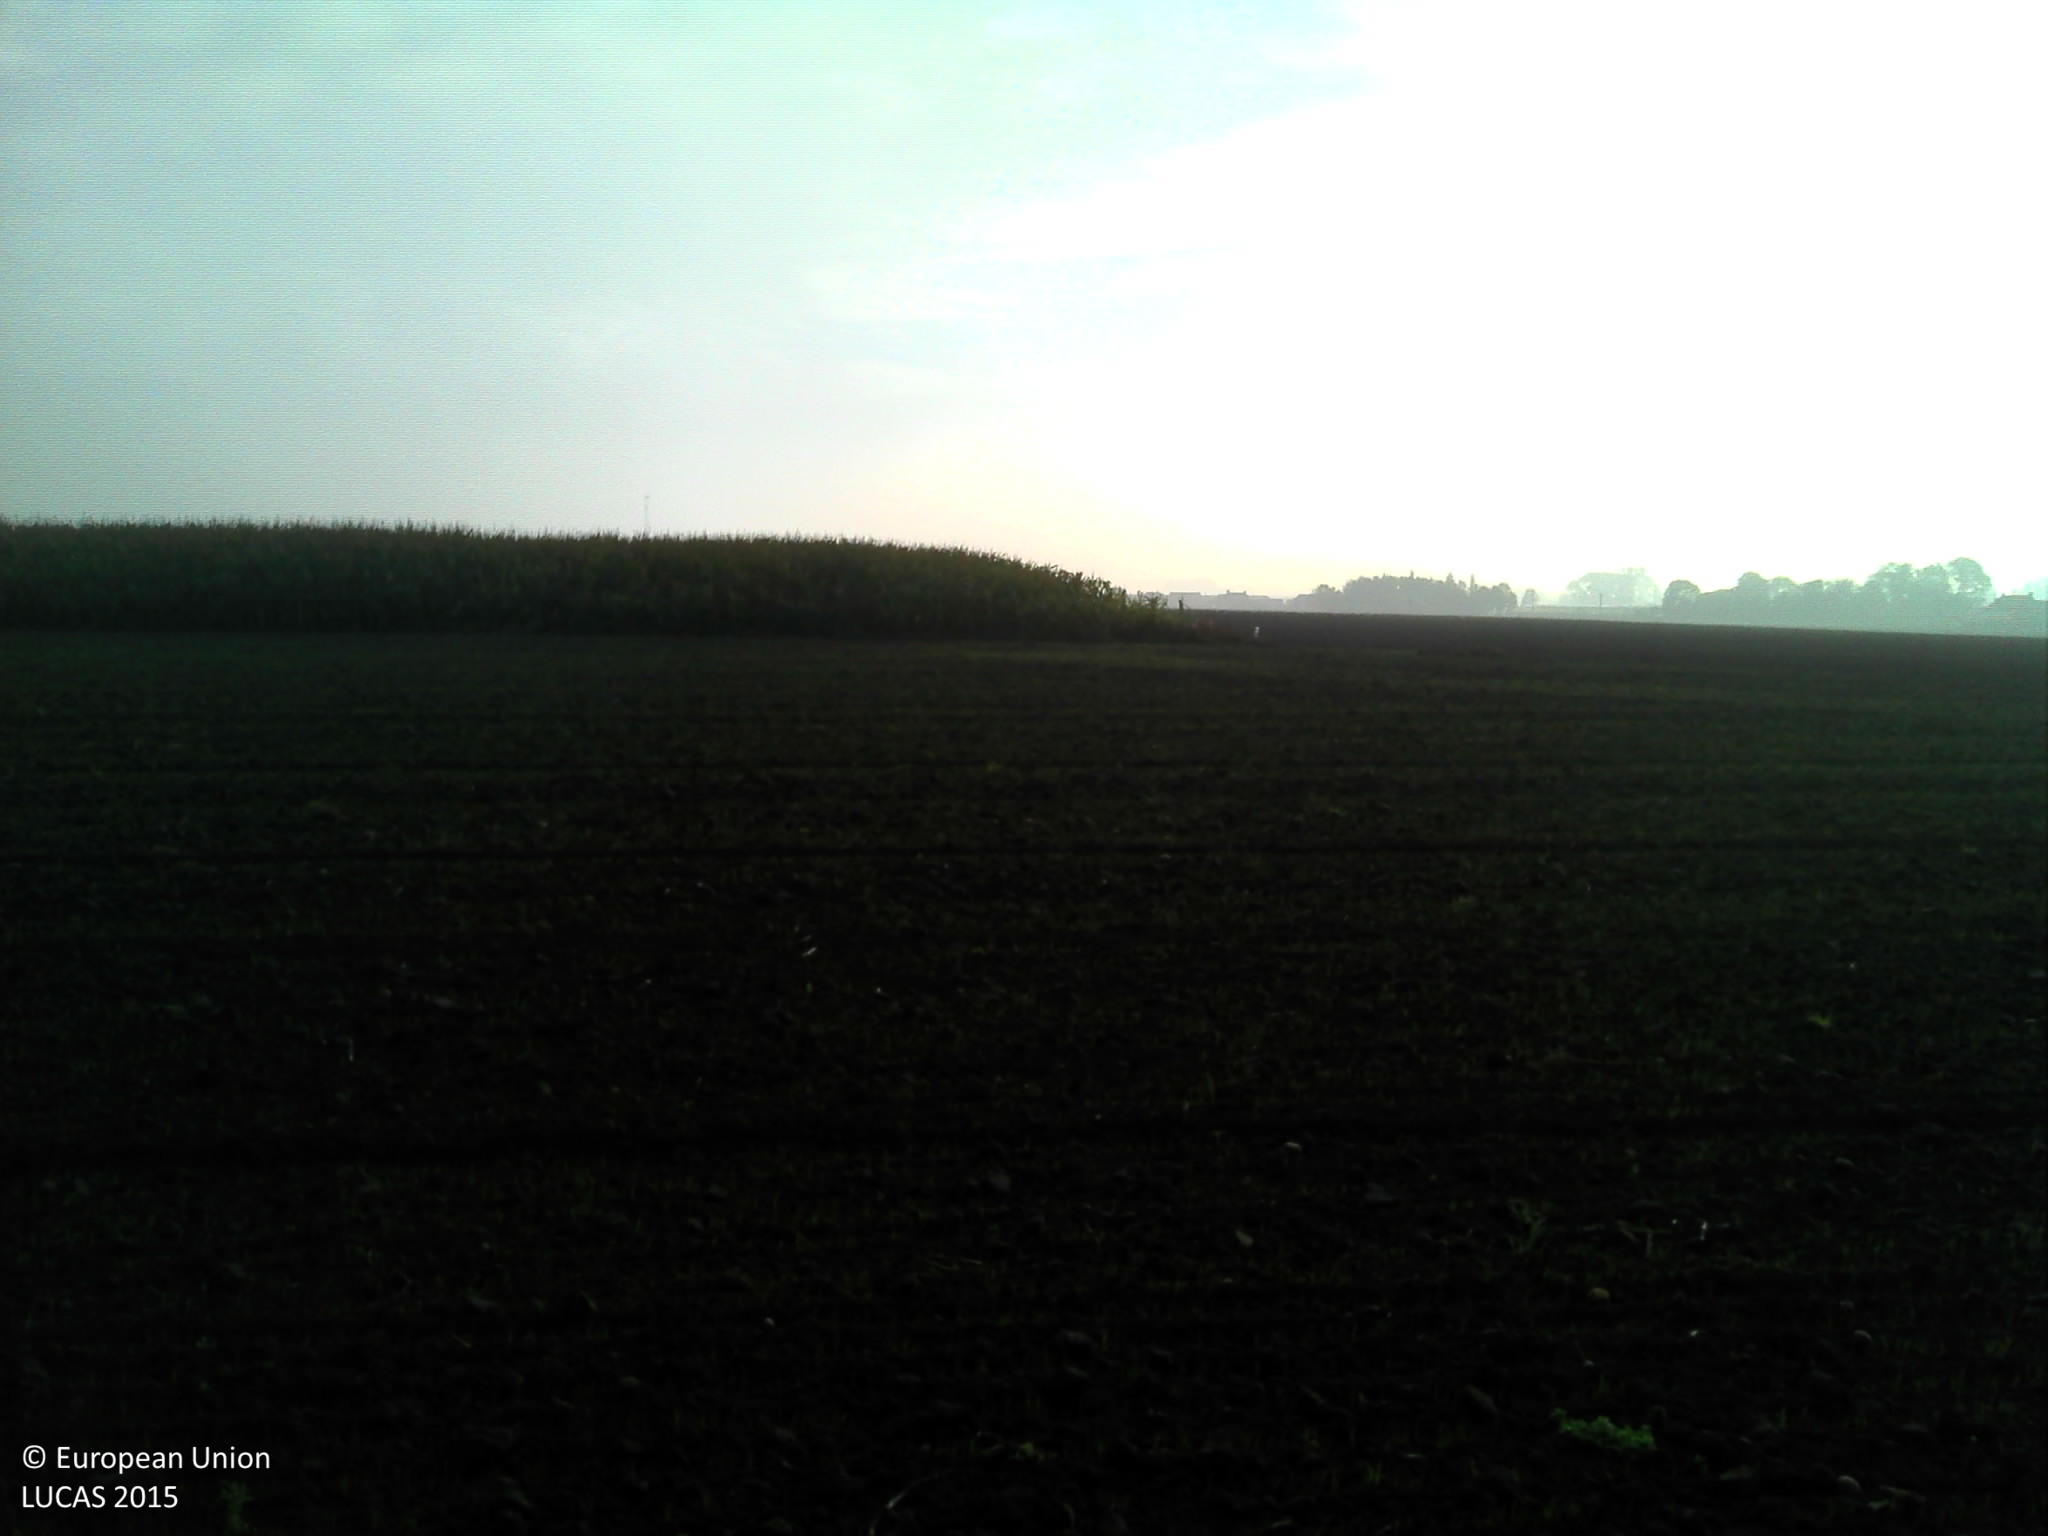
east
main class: Cropland
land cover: Temporary grasslands
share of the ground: < 10 %
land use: Agriculture (excluding fallow land and kitchen gardens)
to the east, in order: Temporary grasslands; Maize; Common wheat; Maize; Temporary grasslands
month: October
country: BE
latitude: 50.9403
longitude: 2.9451
